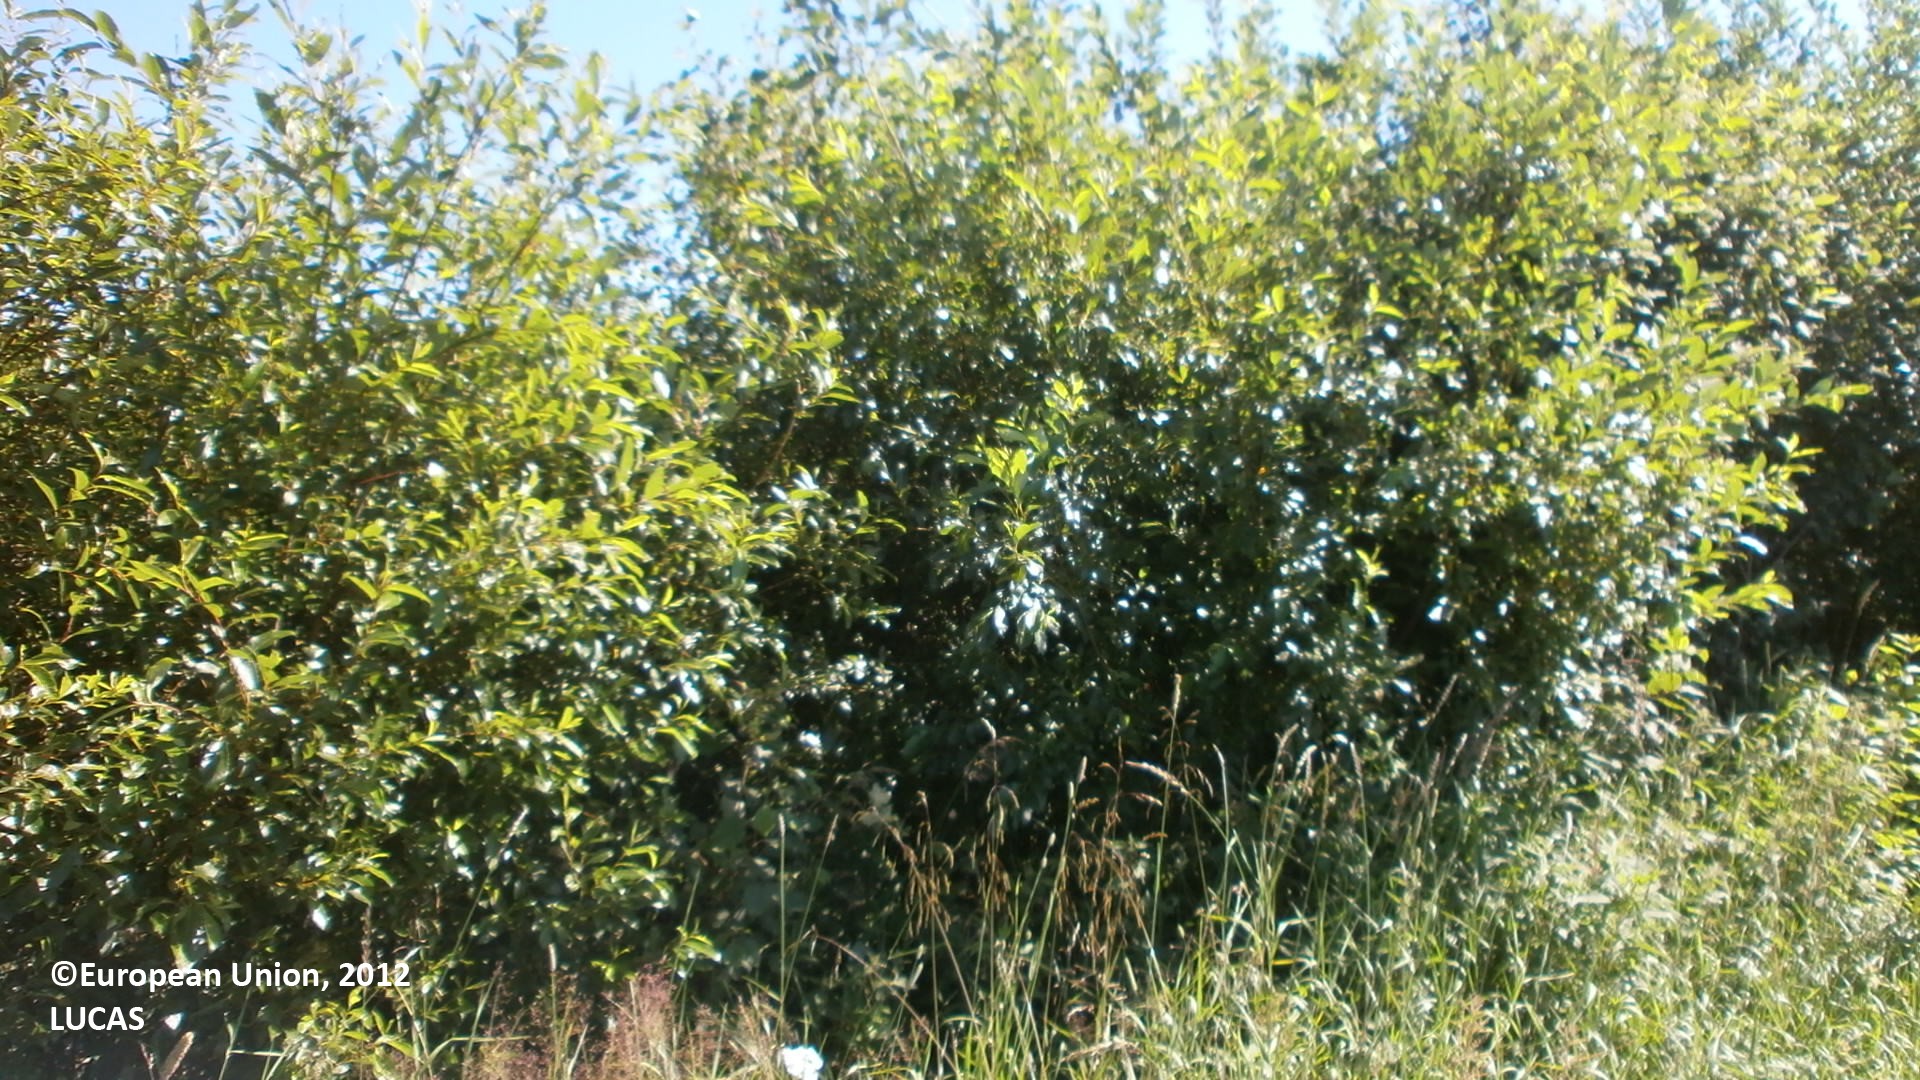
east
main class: Cropland
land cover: Barley
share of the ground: > 75 %
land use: Agriculture (excluding fallow land and kitchen gardens)
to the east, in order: Barley; Shruby margins; Abandoned hedges; Ditches and canals; Shruby margins; Barley; Shruby margins; Ditches and canals; Abandoned hedges; Shruby margins; Spruce dominated coniferous woodland; Tracks; Spruce dominated coniferous woodland; Tracks; Spruce dominated coniferous woodland
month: July
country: FI
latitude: 64.1227
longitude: 23.7992
